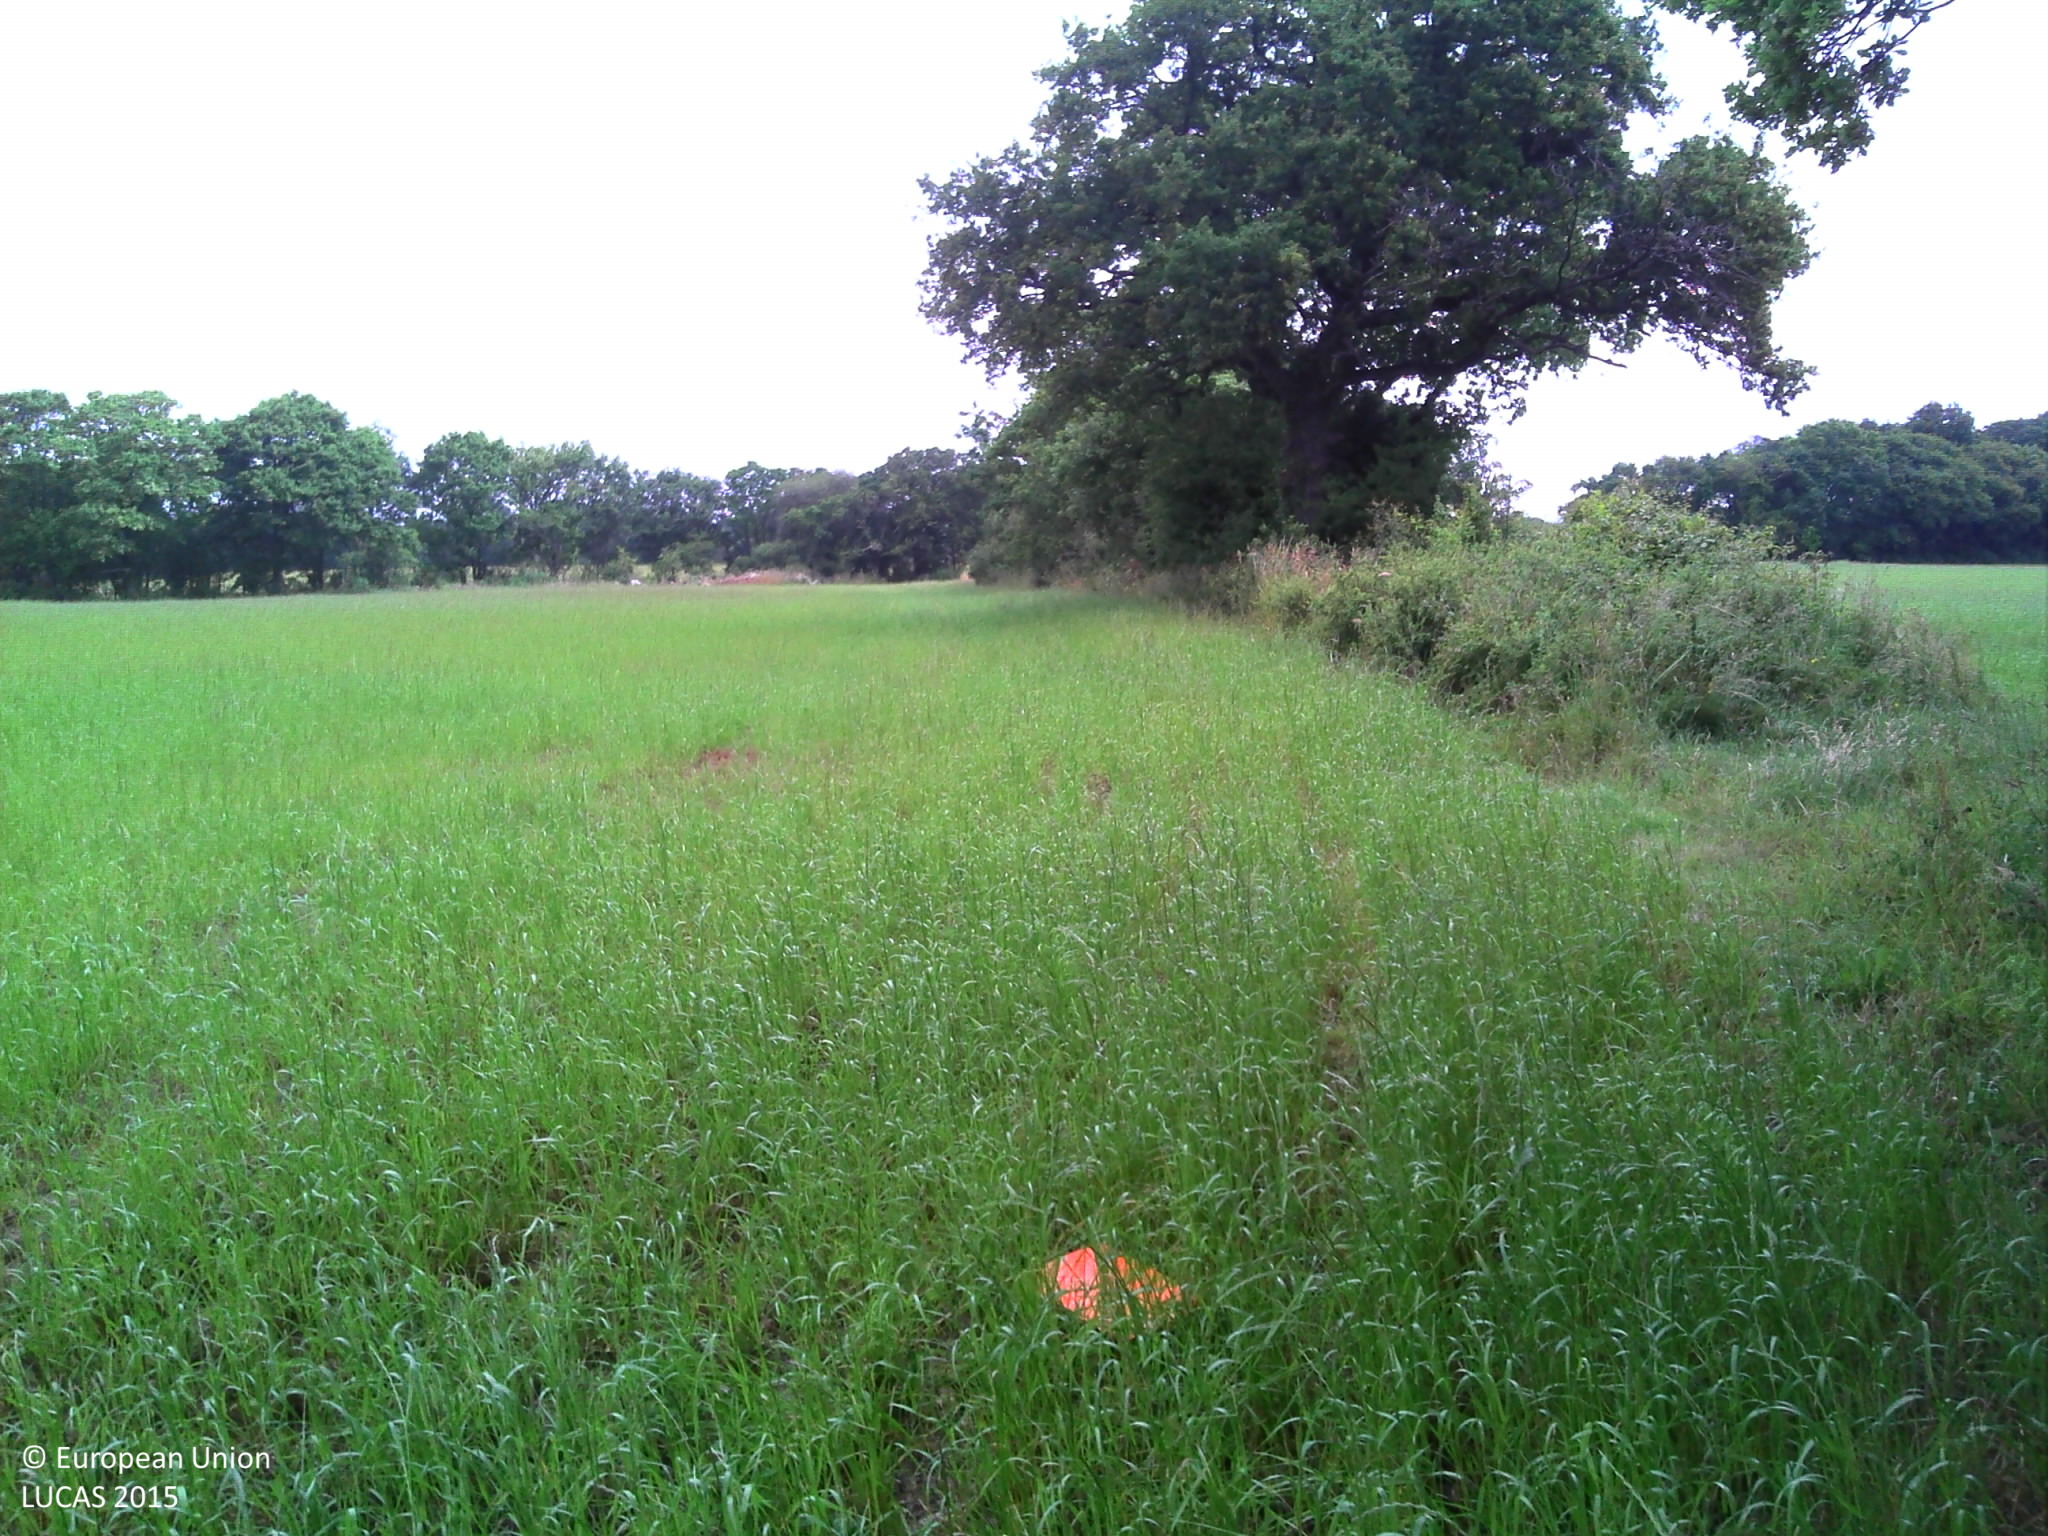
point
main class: Cropland
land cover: Temporary grasslands
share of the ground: > 75 %
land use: Agriculture (excluding fallow land and kitchen gardens)
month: June
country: FR
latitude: 47.0898
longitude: -2.0222
